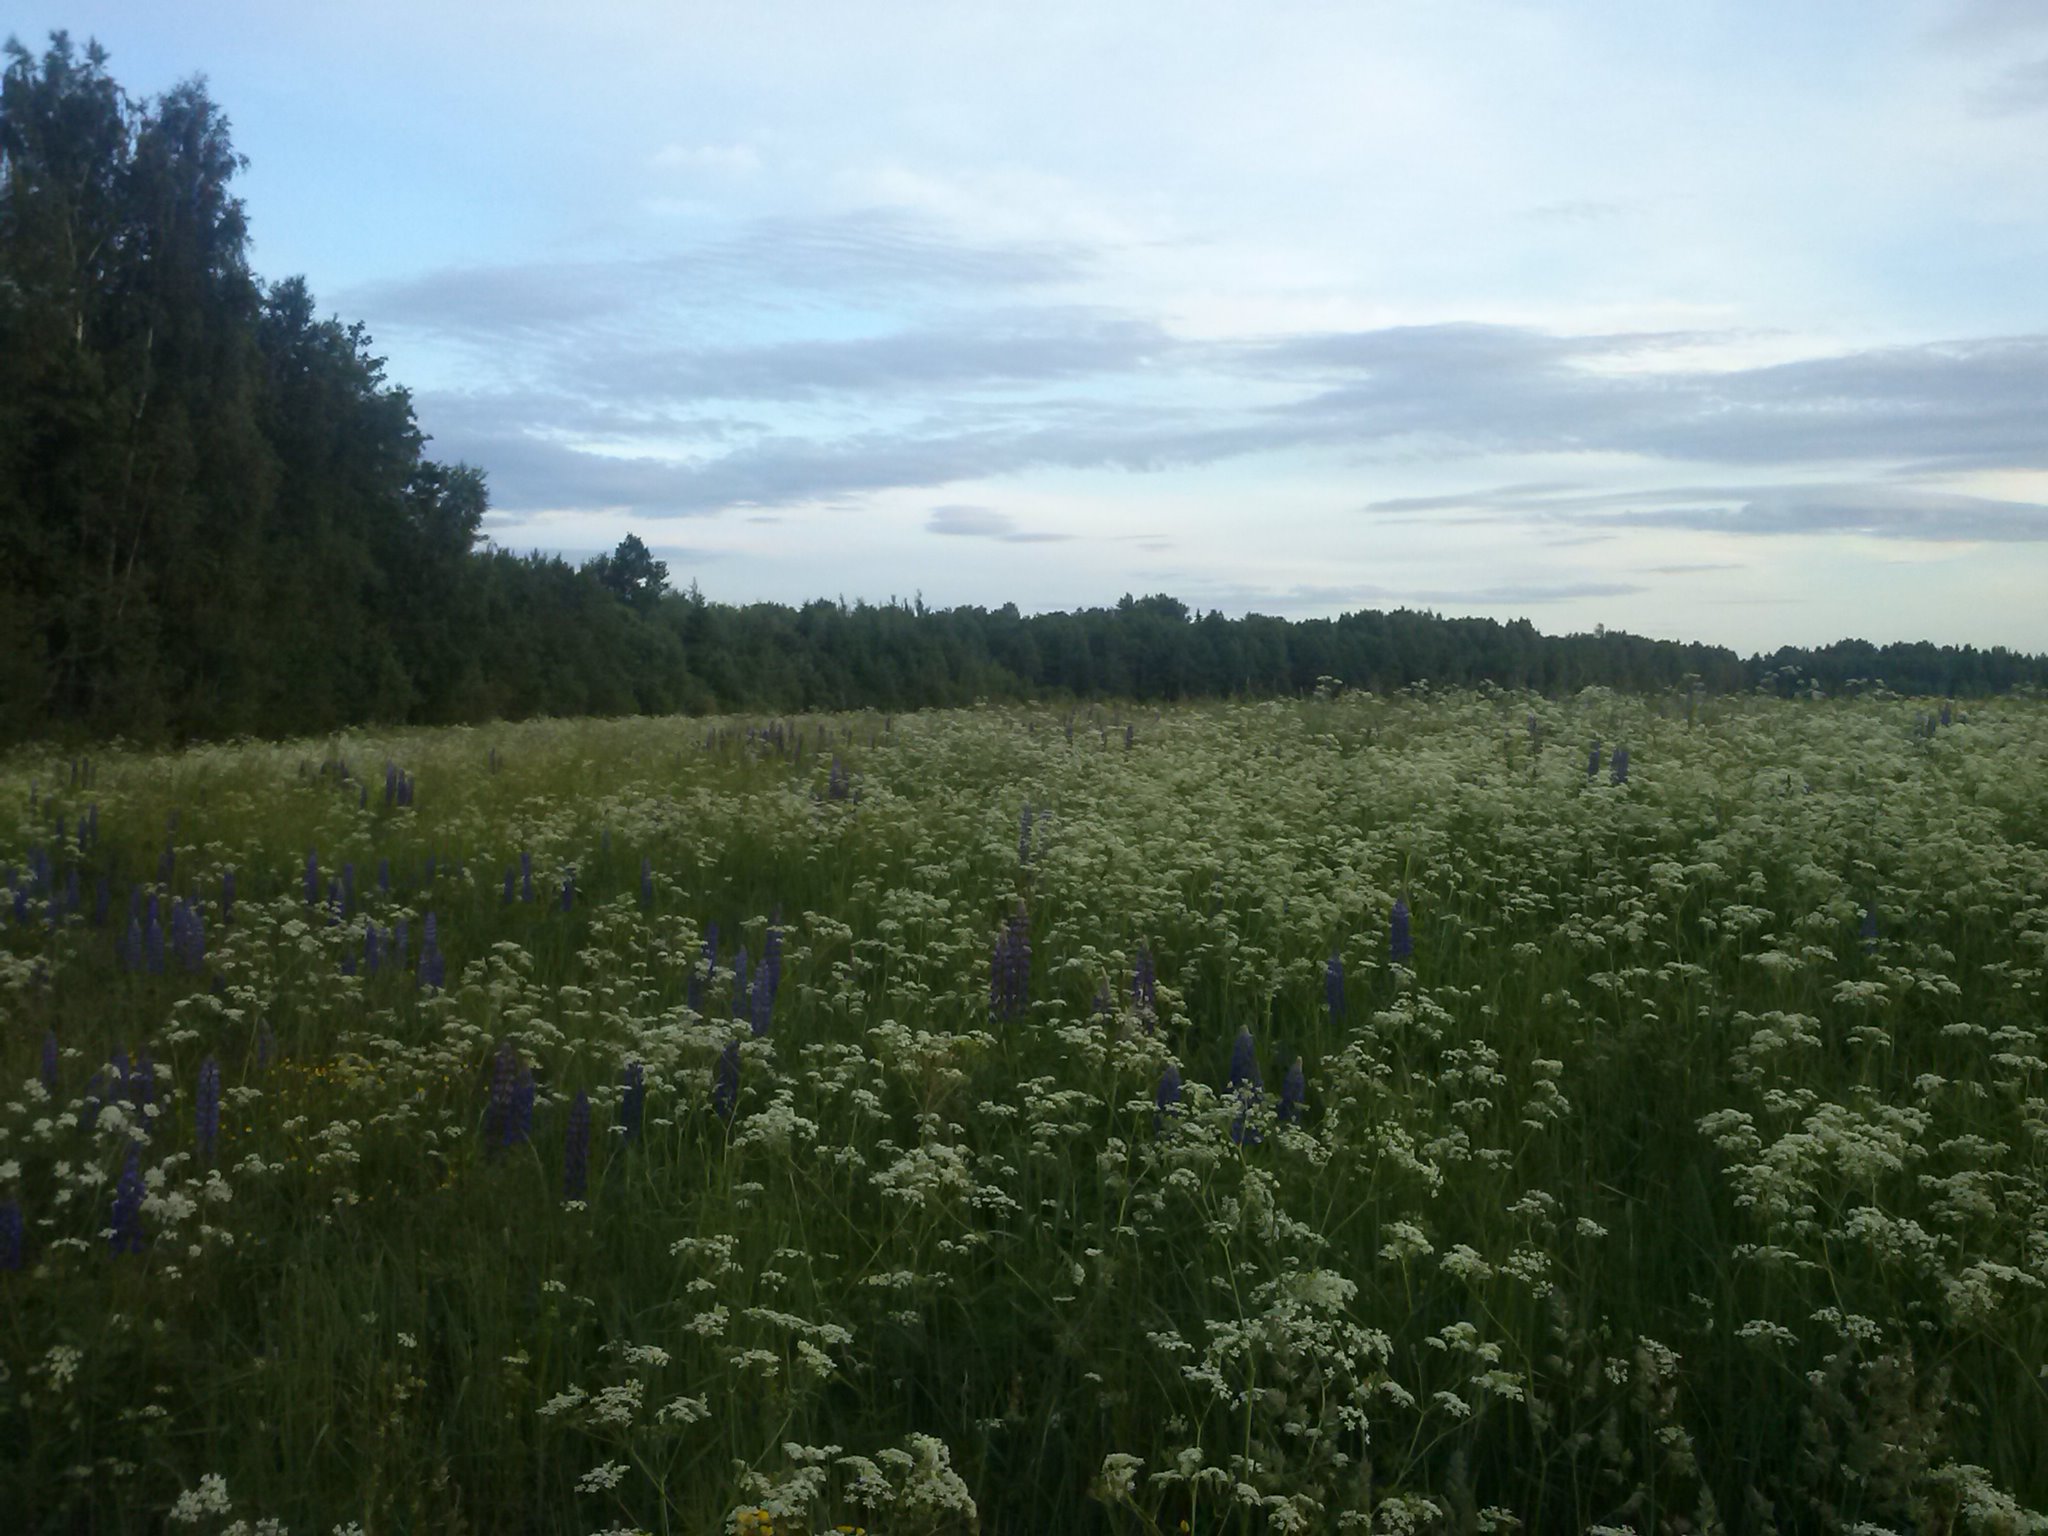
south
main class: Grassland
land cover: Grassland without tree/shrub cover
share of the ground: > 75 %
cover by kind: herbaceous plants 100 %
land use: Agriculture (excluding fallow land and kitchen gardens)
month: June
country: LV
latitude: 56.5267
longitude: 27.4587
